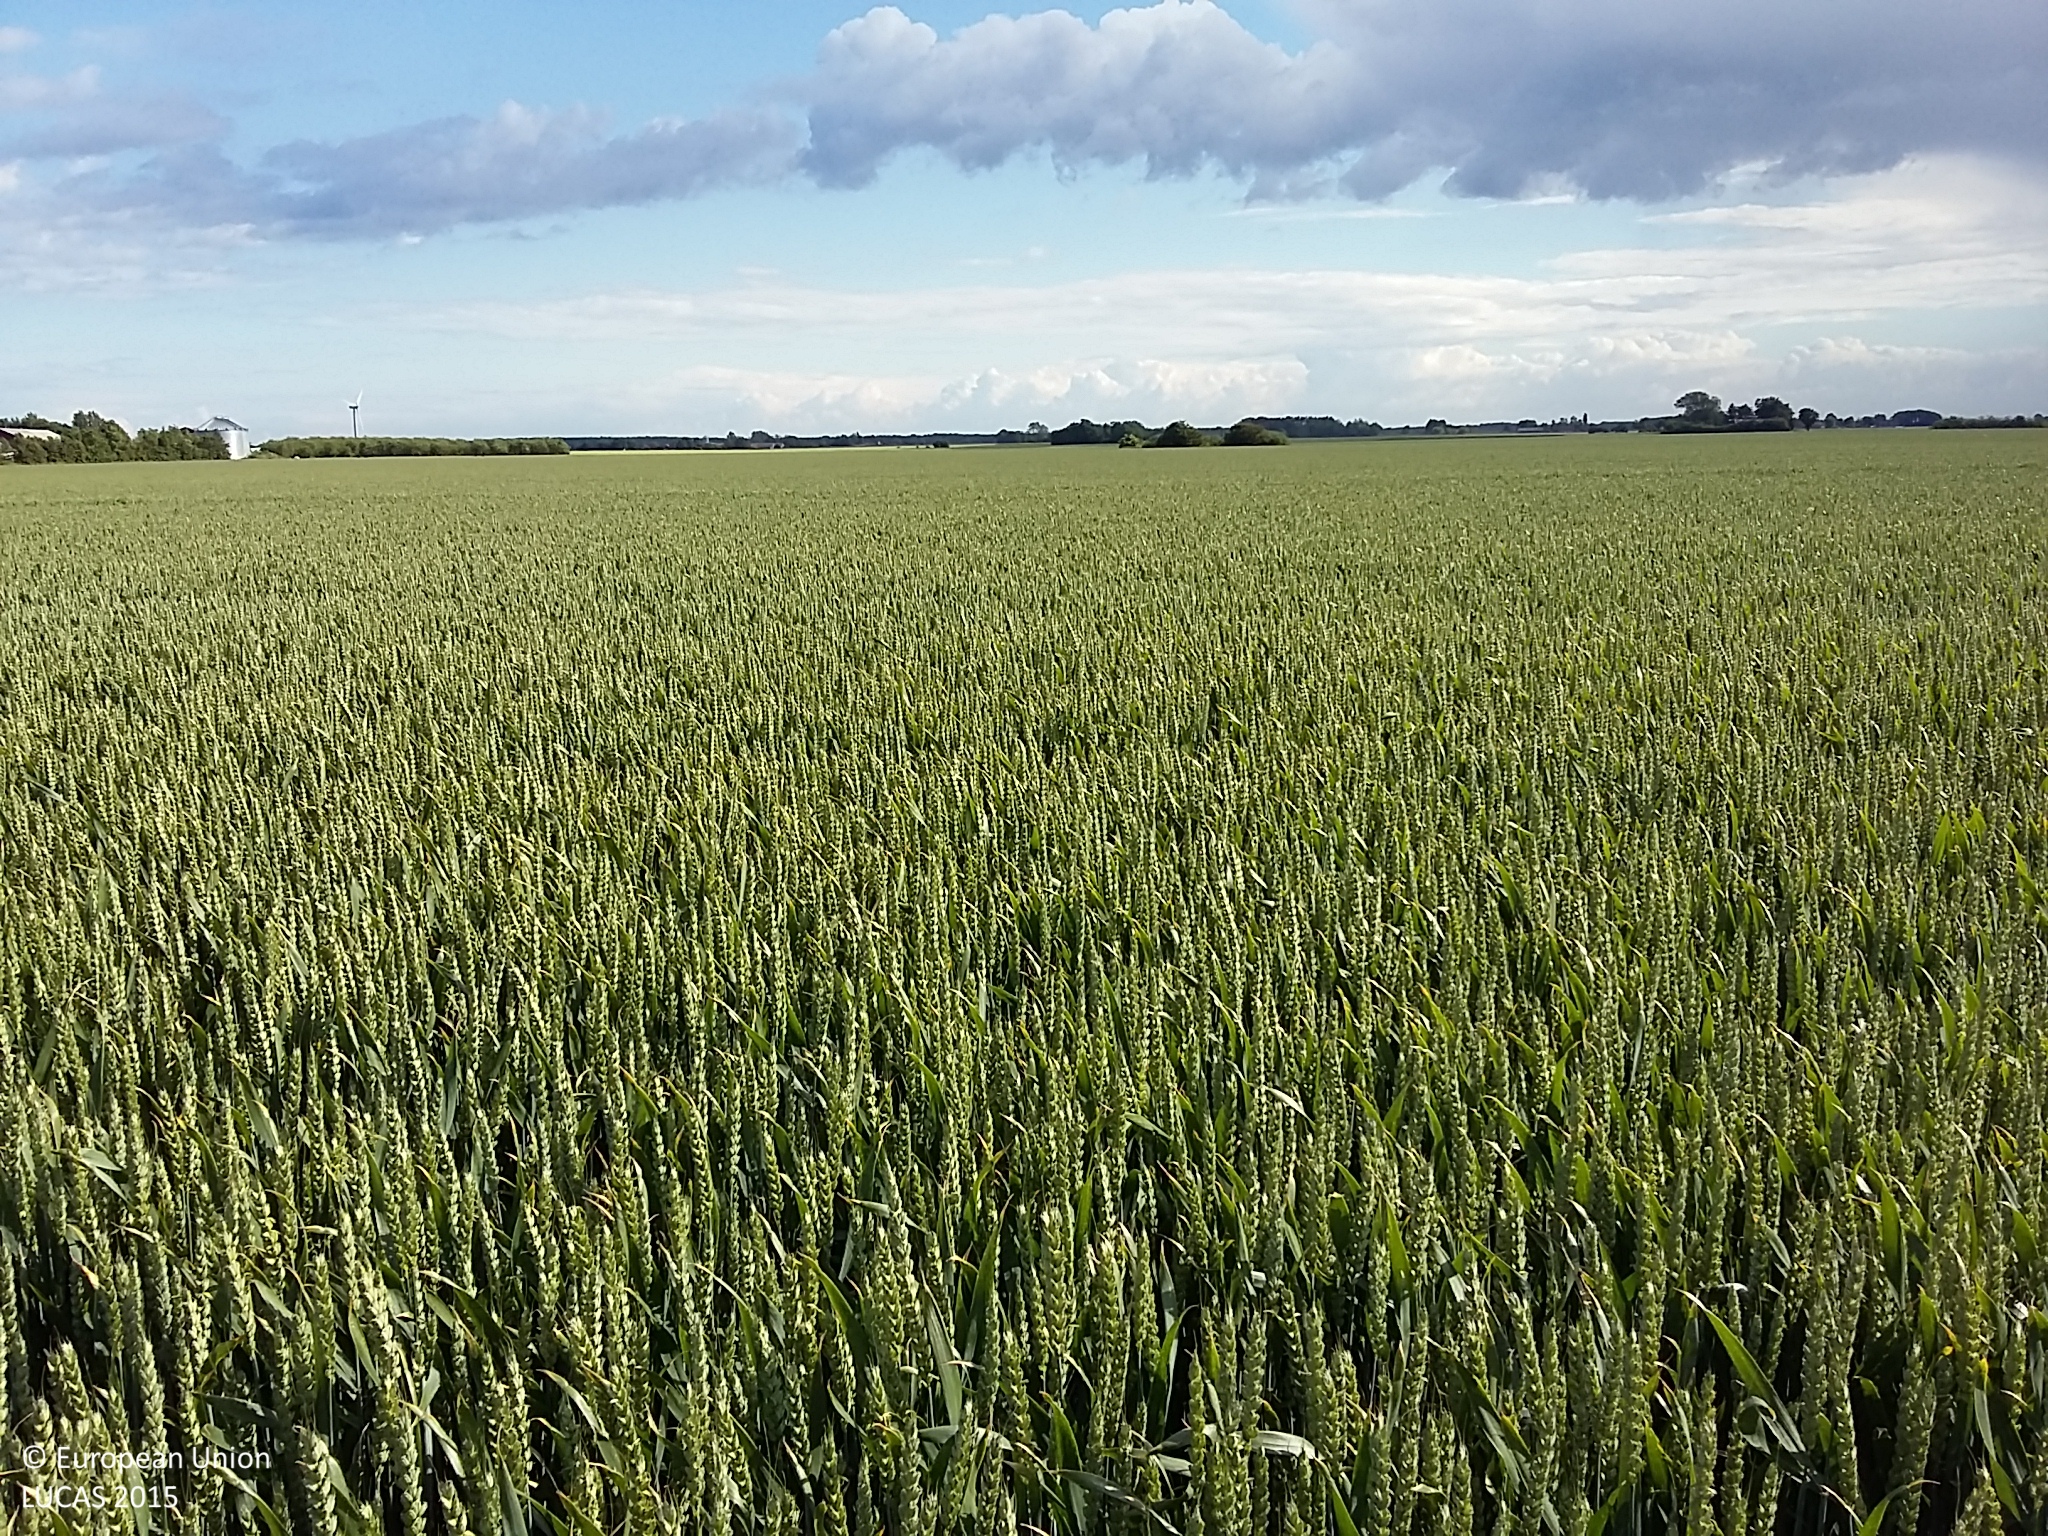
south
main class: Cropland
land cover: Common wheat
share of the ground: > 75 %
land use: Agriculture (excluding fallow land and kitchen gardens)
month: June
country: DK
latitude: 54.7809
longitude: 11.1031
